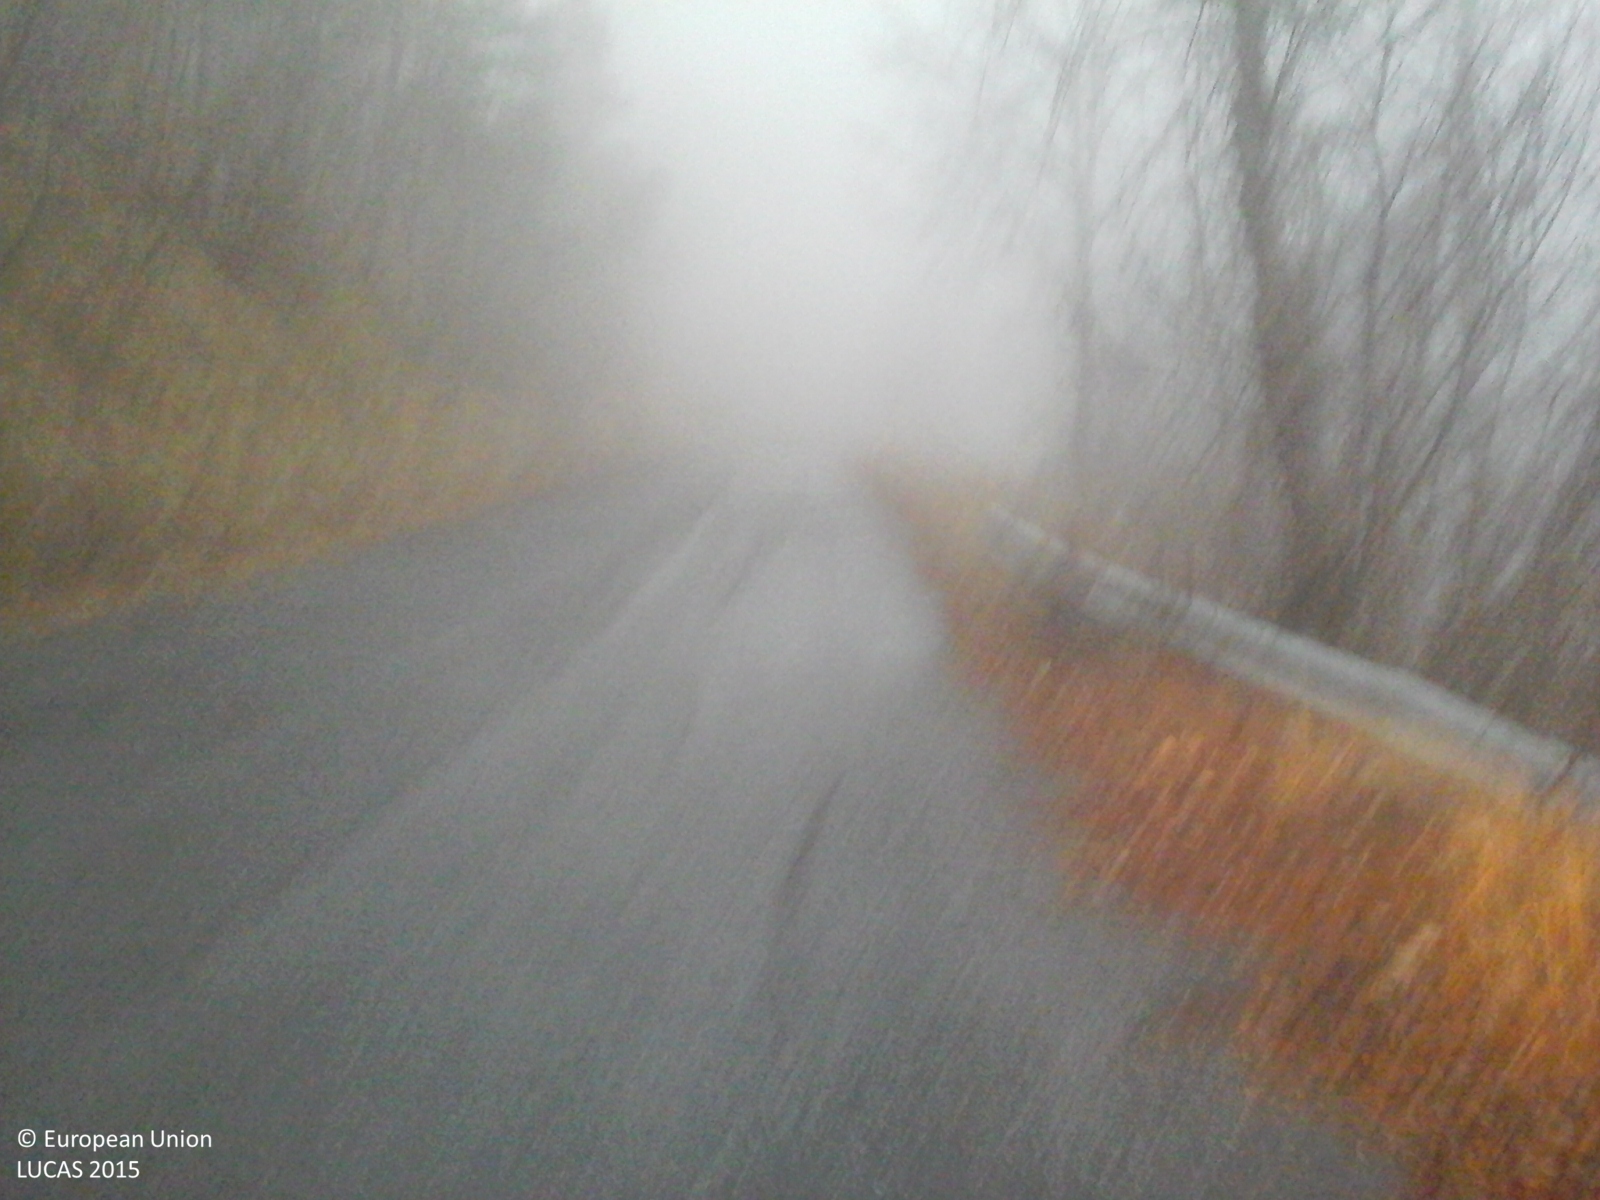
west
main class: Woodland
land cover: Broadleaved woodland
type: thermophilous deciduous forest
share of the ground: > 75 %
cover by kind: broadleaved forest trees 80 %, coniferous forest trees 20 %
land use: Forestry
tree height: > 5 m
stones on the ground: 10 - 25 %
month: January
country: IT
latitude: 44.0931
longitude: 7.8192
